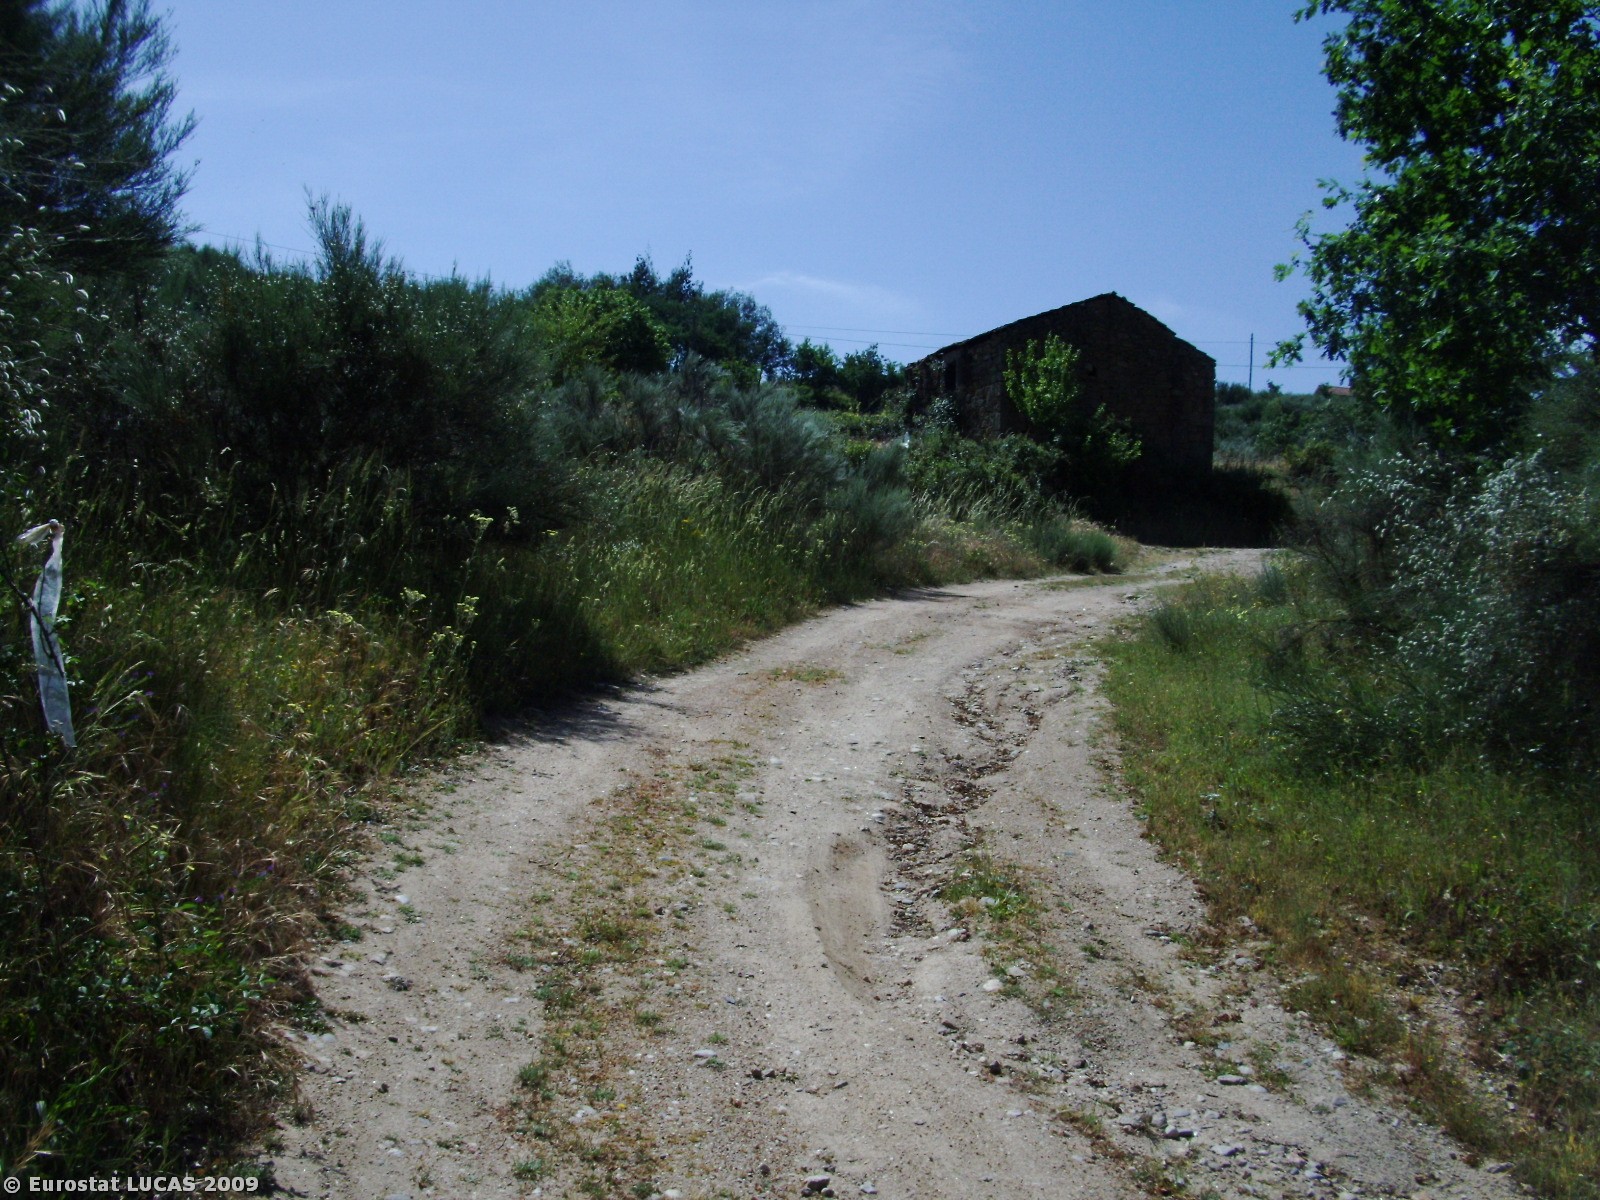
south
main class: Shrubland
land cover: Shrubland with sparse tree cover
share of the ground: > 75 %
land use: Unused
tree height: > 5 m
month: June
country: PT
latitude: 40.6224
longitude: -7.4780
